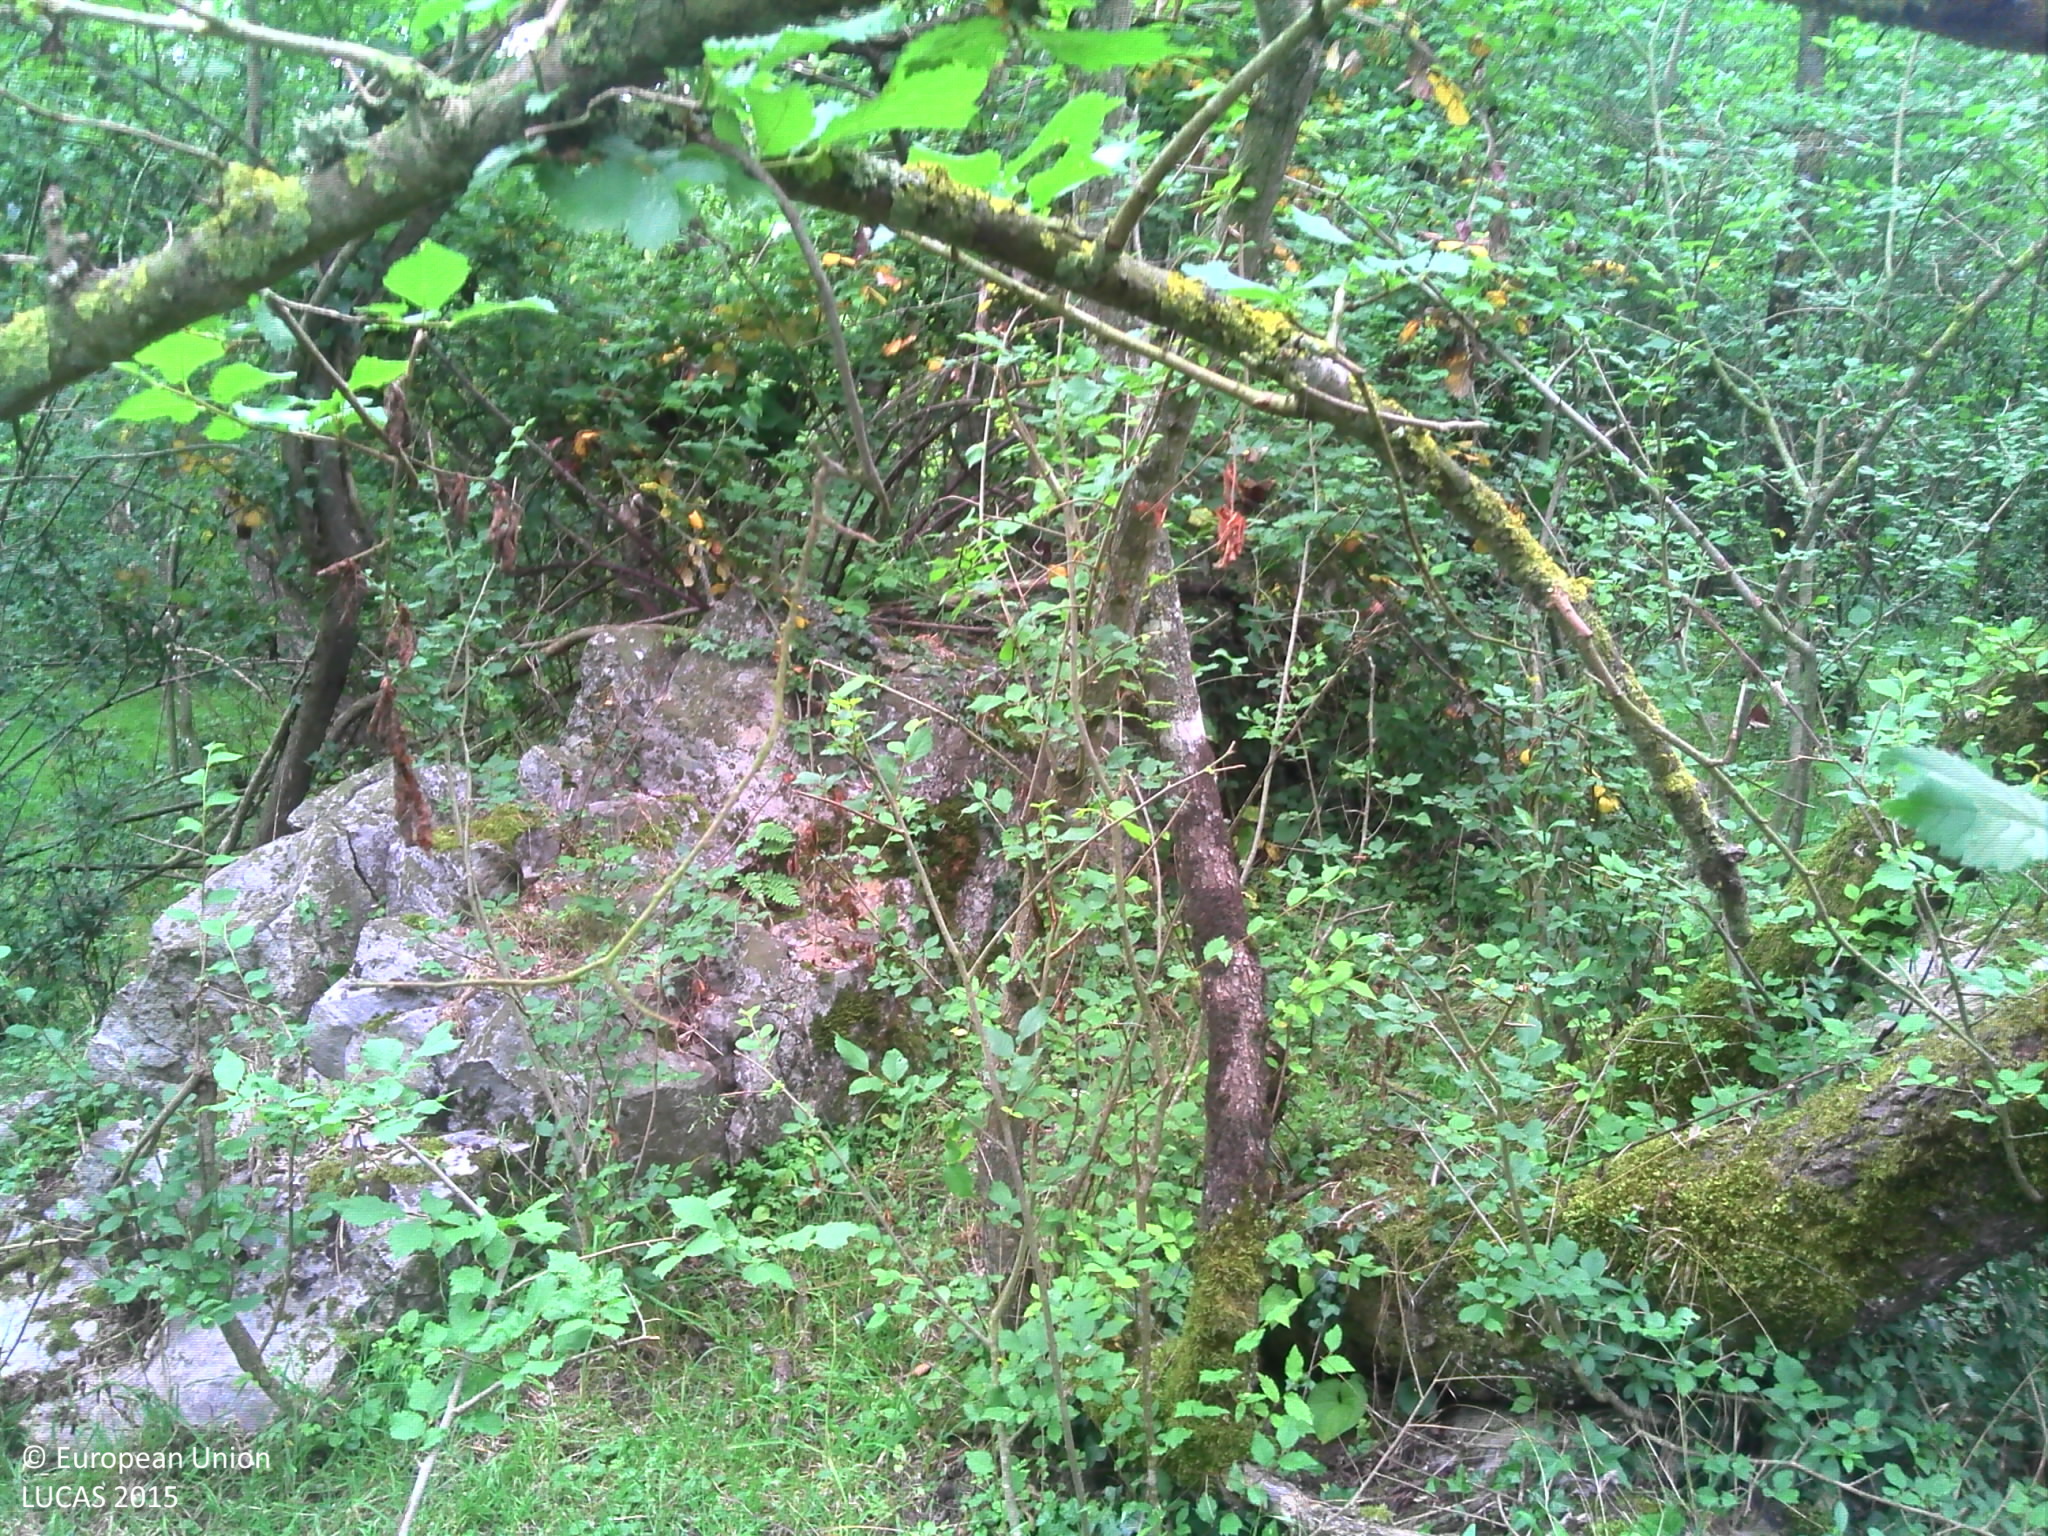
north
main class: Woodland
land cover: Broadleaved woodland
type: mesophytic deciduous forest
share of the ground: > 75 %
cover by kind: broadleaved forest trees 90 %, lichens and mosses 10 %
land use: Forestry
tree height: > 5 m
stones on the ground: 10 - 25 %
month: June
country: FR
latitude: 48.8051
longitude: 0.0443
